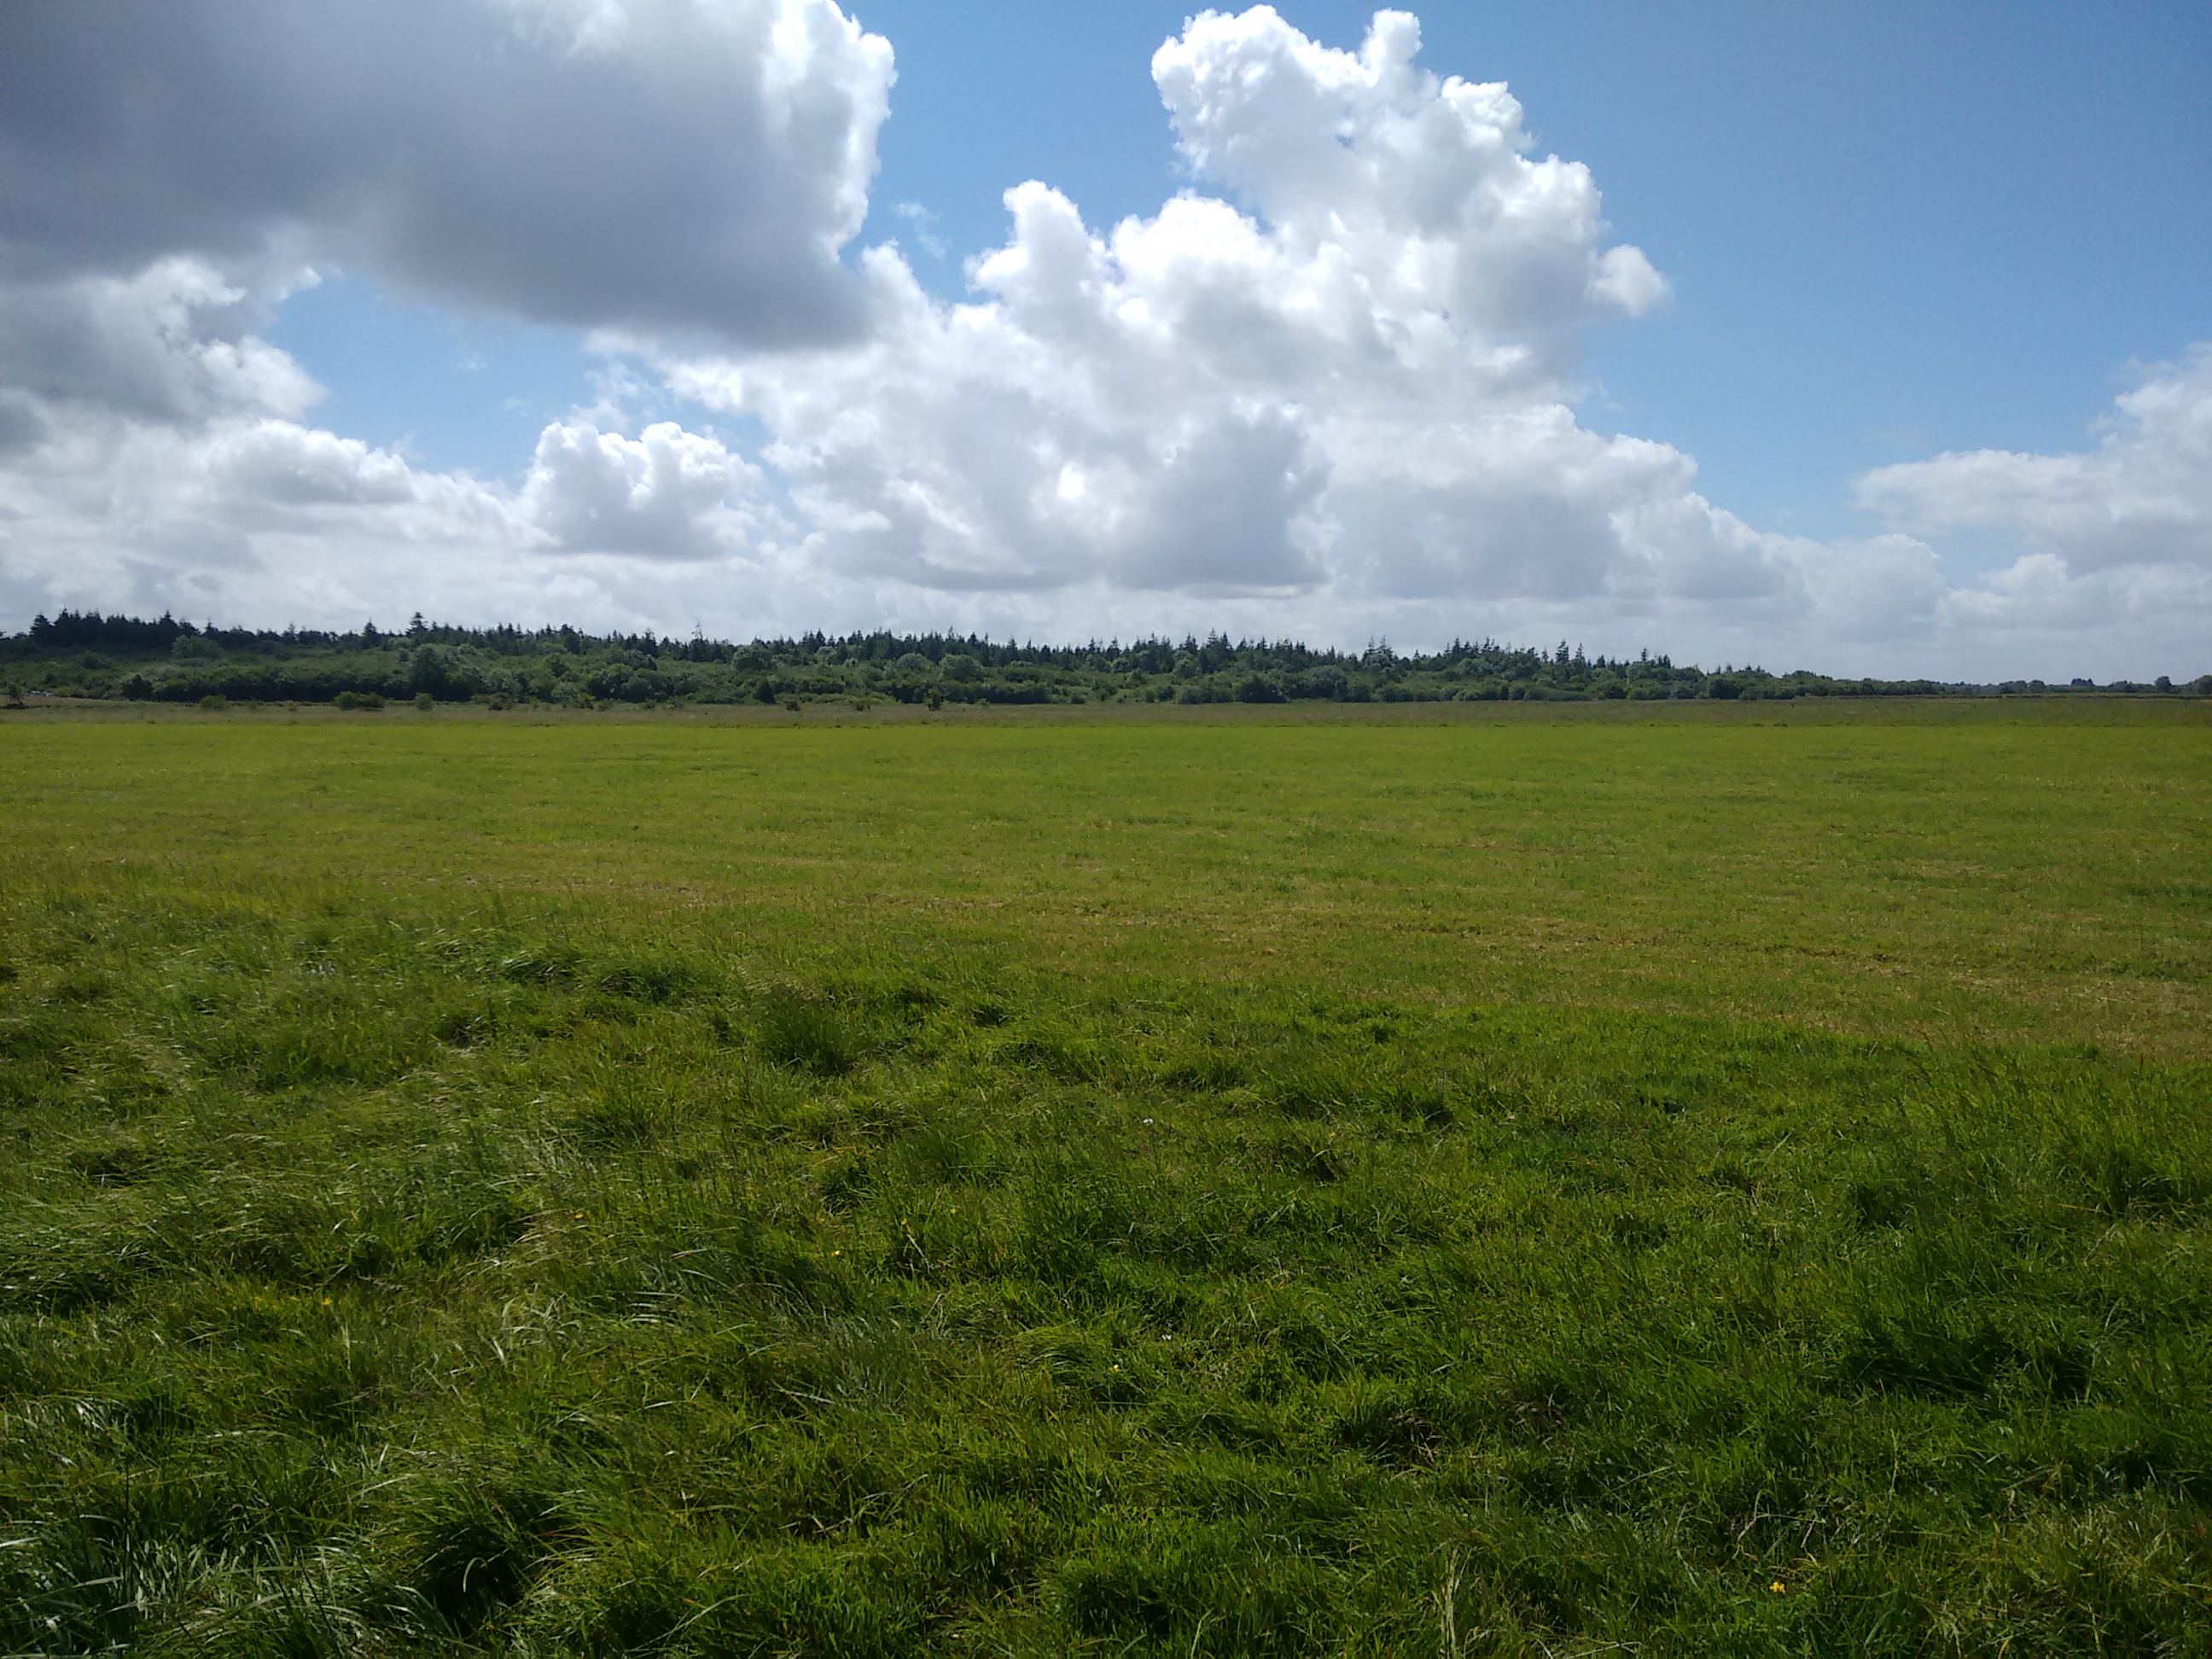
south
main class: Grassland
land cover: Grassland without tree/shrub cover
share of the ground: > 75 %
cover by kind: herbaceous plants 95 %, consolidated bare surface 5 %
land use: Agriculture (excluding fallow land and kitchen gardens)
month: June
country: IE
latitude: 53.3067
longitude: -8.0197
